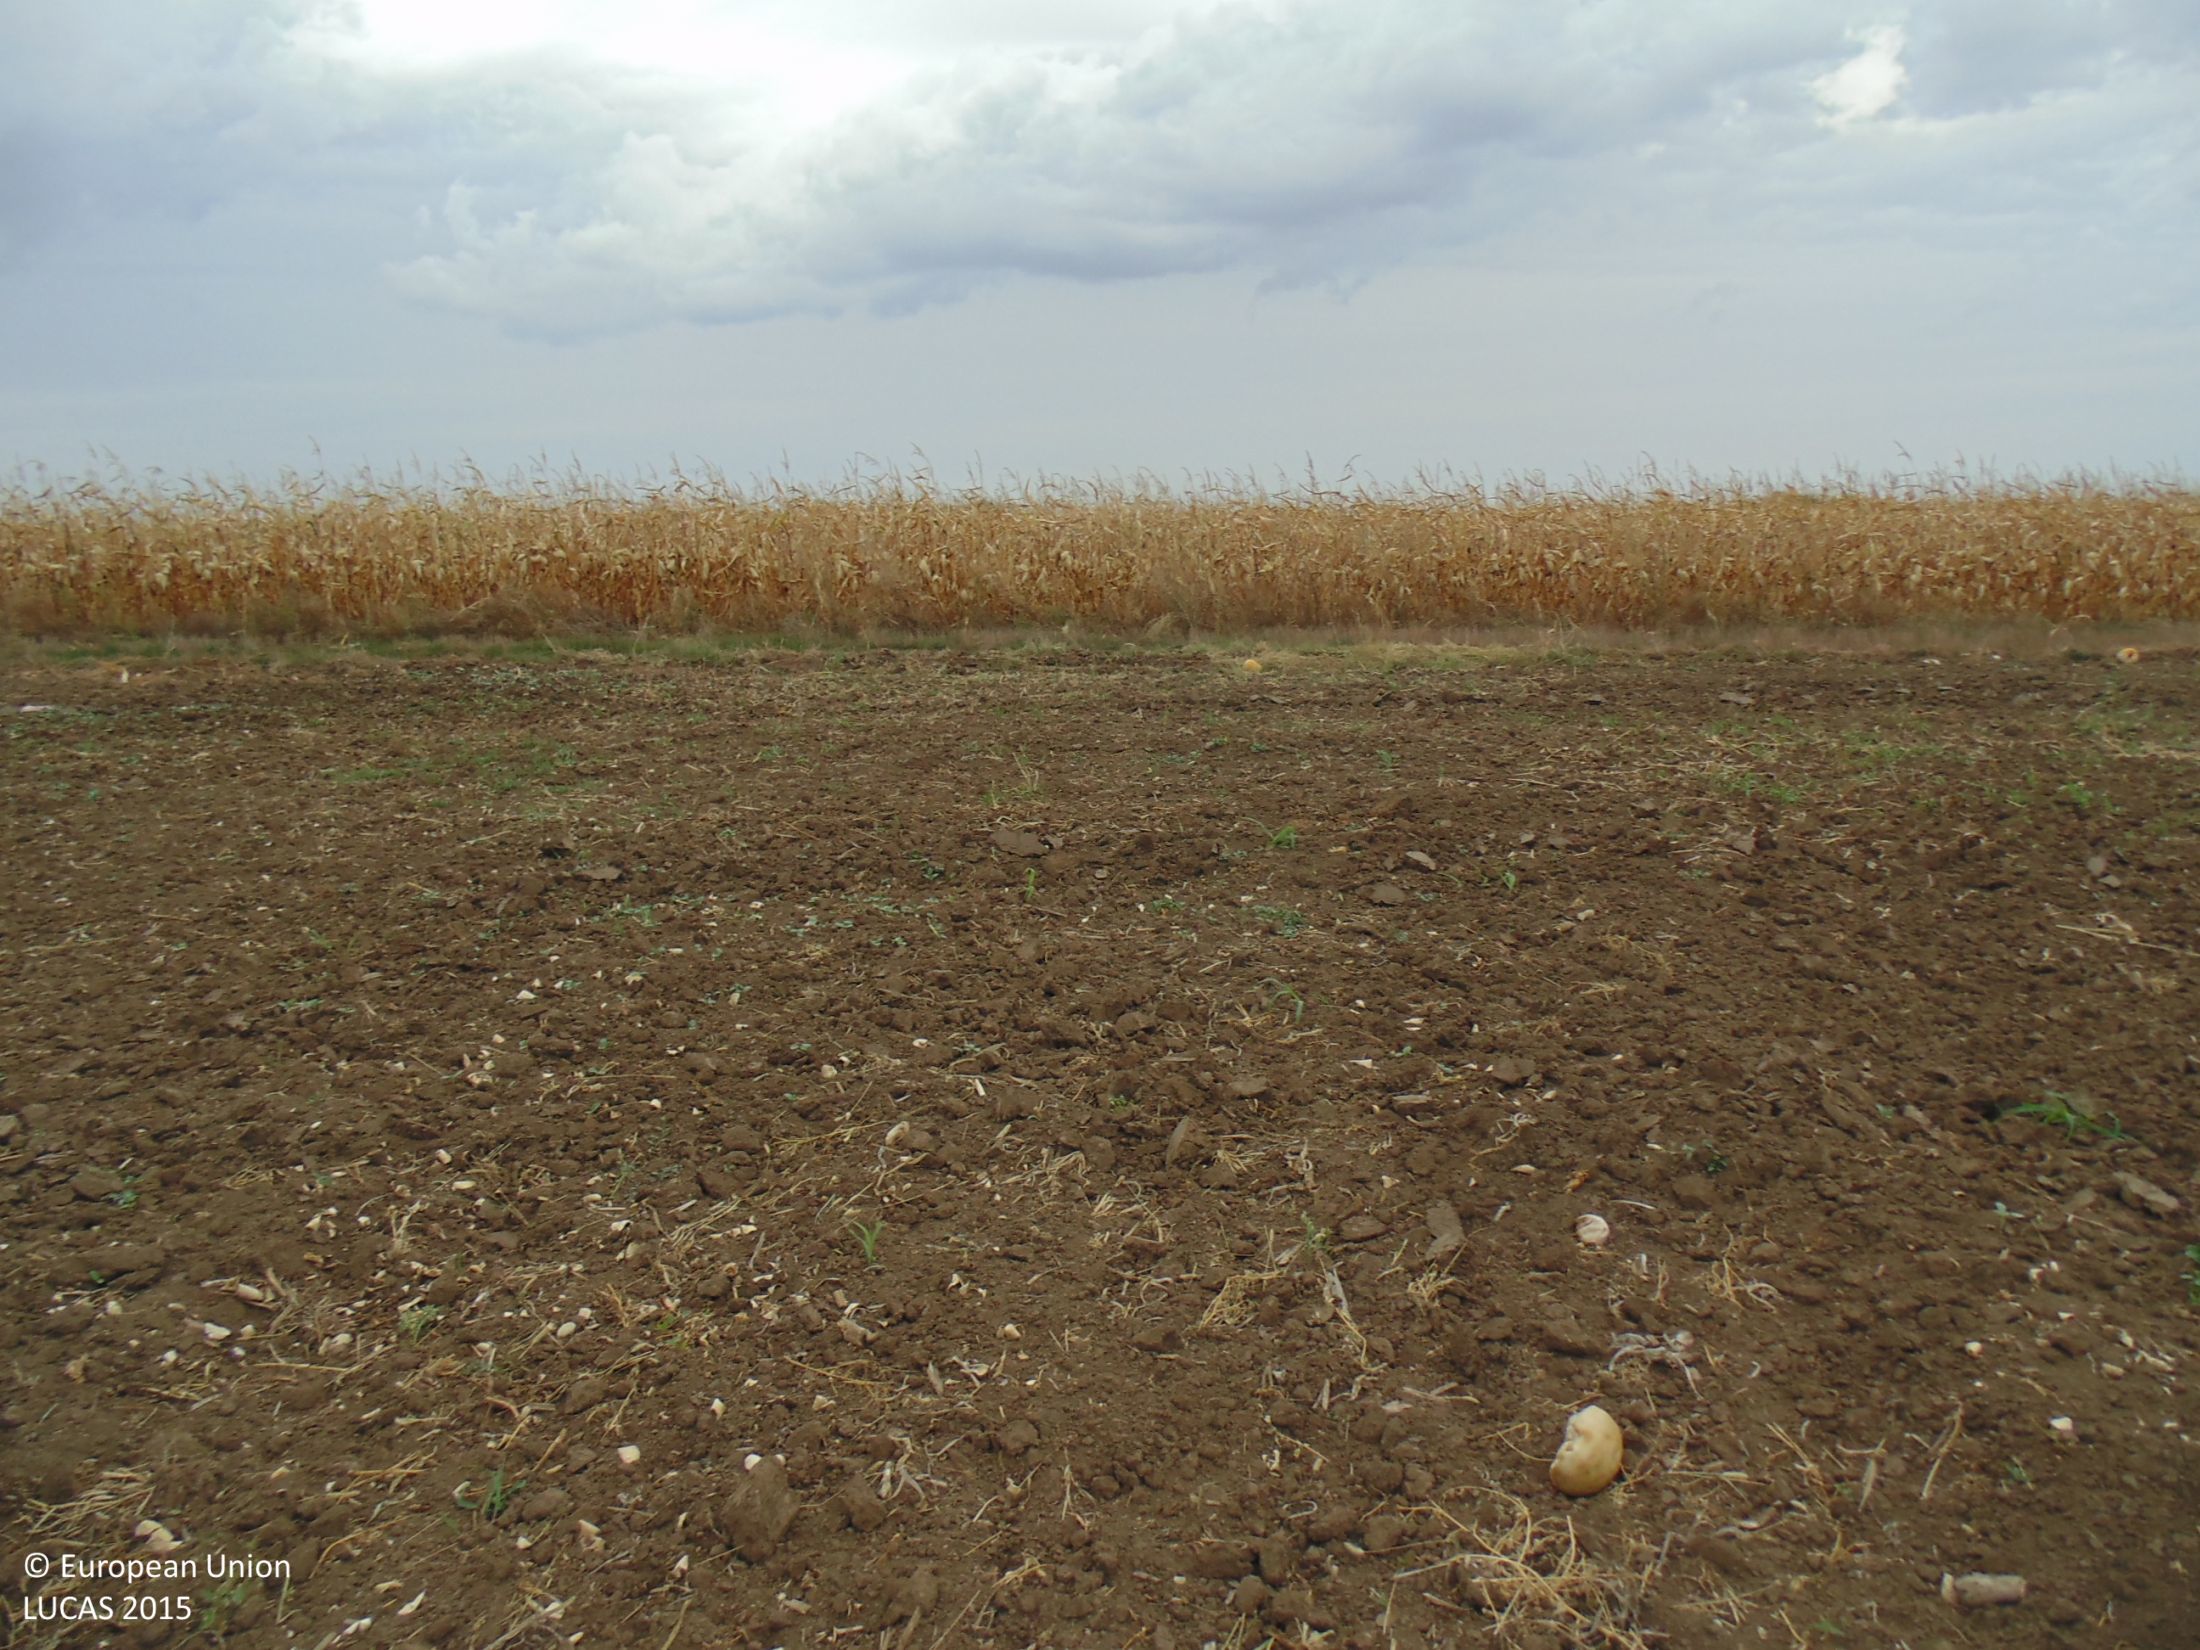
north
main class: Cropland
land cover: Other fresh vegetables
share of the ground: < 10 %
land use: Agriculture (excluding fallow land and kitchen gardens)
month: September
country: BG
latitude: 44.0030
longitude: 26.9972
